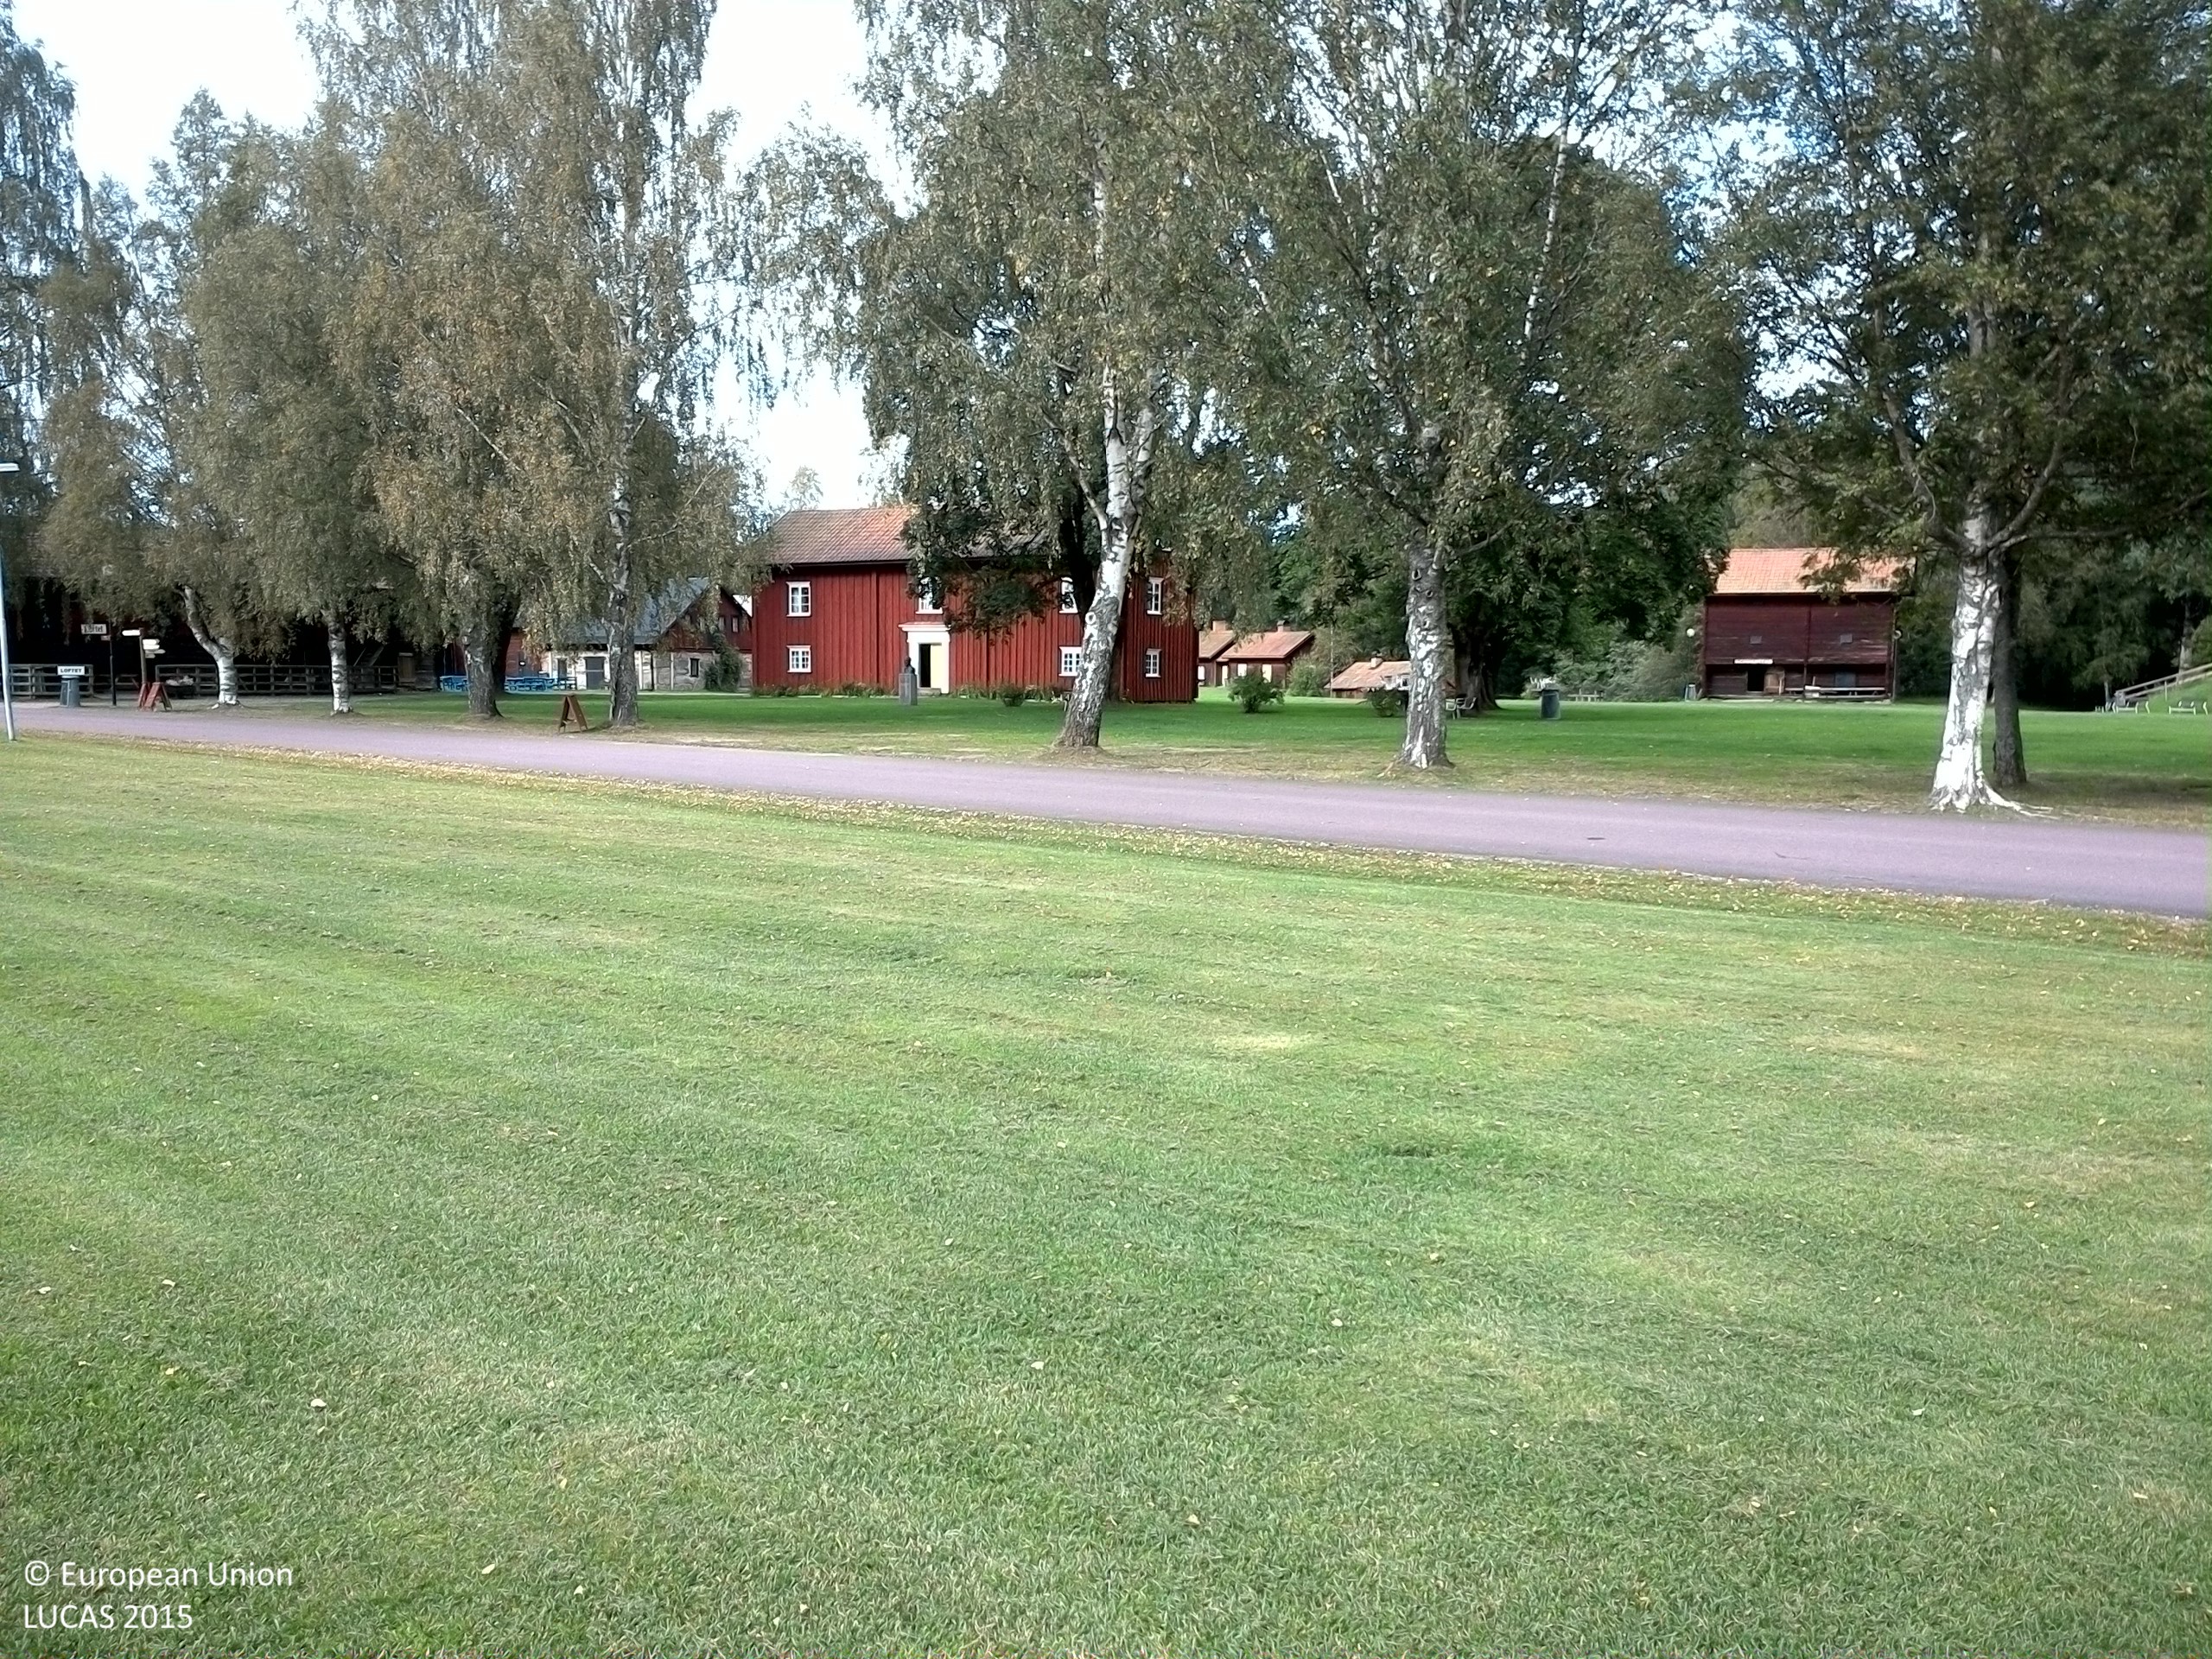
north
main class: Grassland
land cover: Grassland without tree/shrub cover
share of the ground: > 75 %
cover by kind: herbaceous plants 95 %, consolidated bare surface 5 %
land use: Amenities, museums, leisure
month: September
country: SE
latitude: 59.7778
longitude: 13.4645
